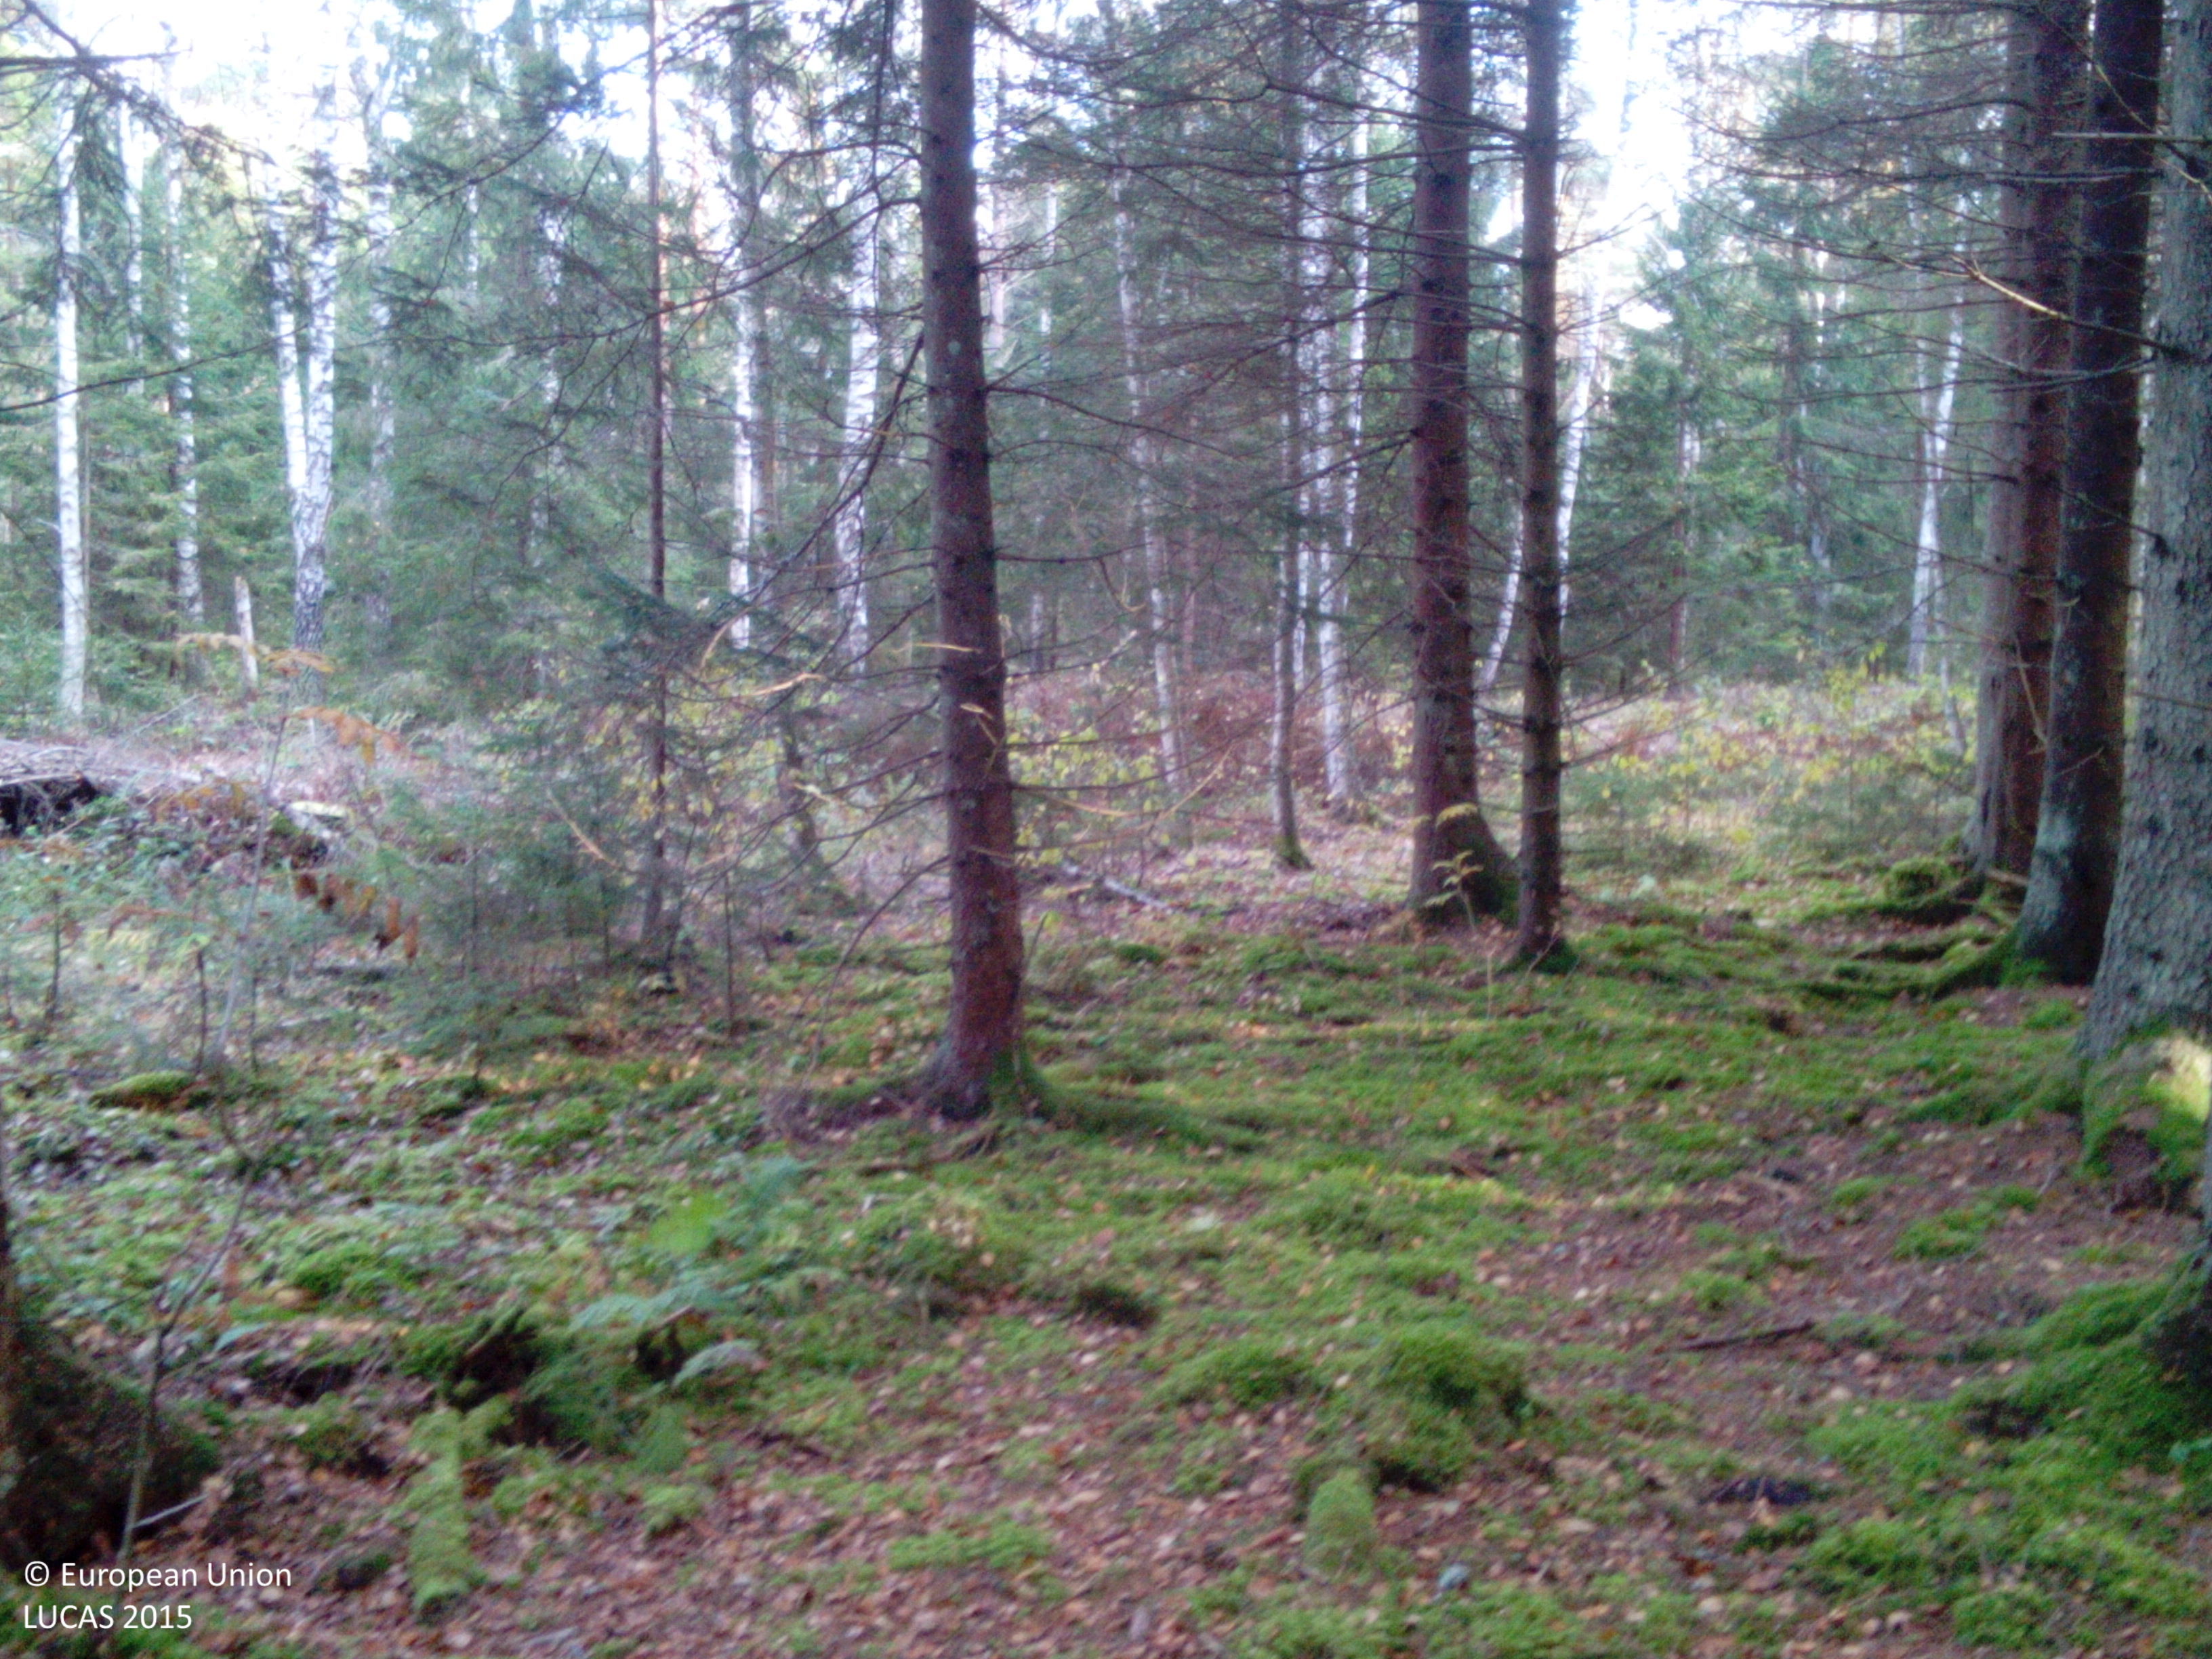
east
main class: Woodland
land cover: Spruce dominated coniferous woodland
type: boreal forest
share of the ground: > 75 %
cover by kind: coniferous forest trees 90 %, lichens and mosses 10 %
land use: Forestry
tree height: > 5 m
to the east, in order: Spruce dominated coniferous woodland; Ditches and canals; Spruce dominated mixed woodland; Pine dominated mixed woodland; Broadleaved woodland; Pine dominated coniferous woodland; Spruce dominated coniferous woodland
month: October
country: SE
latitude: 59.0130
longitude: 16.2454
